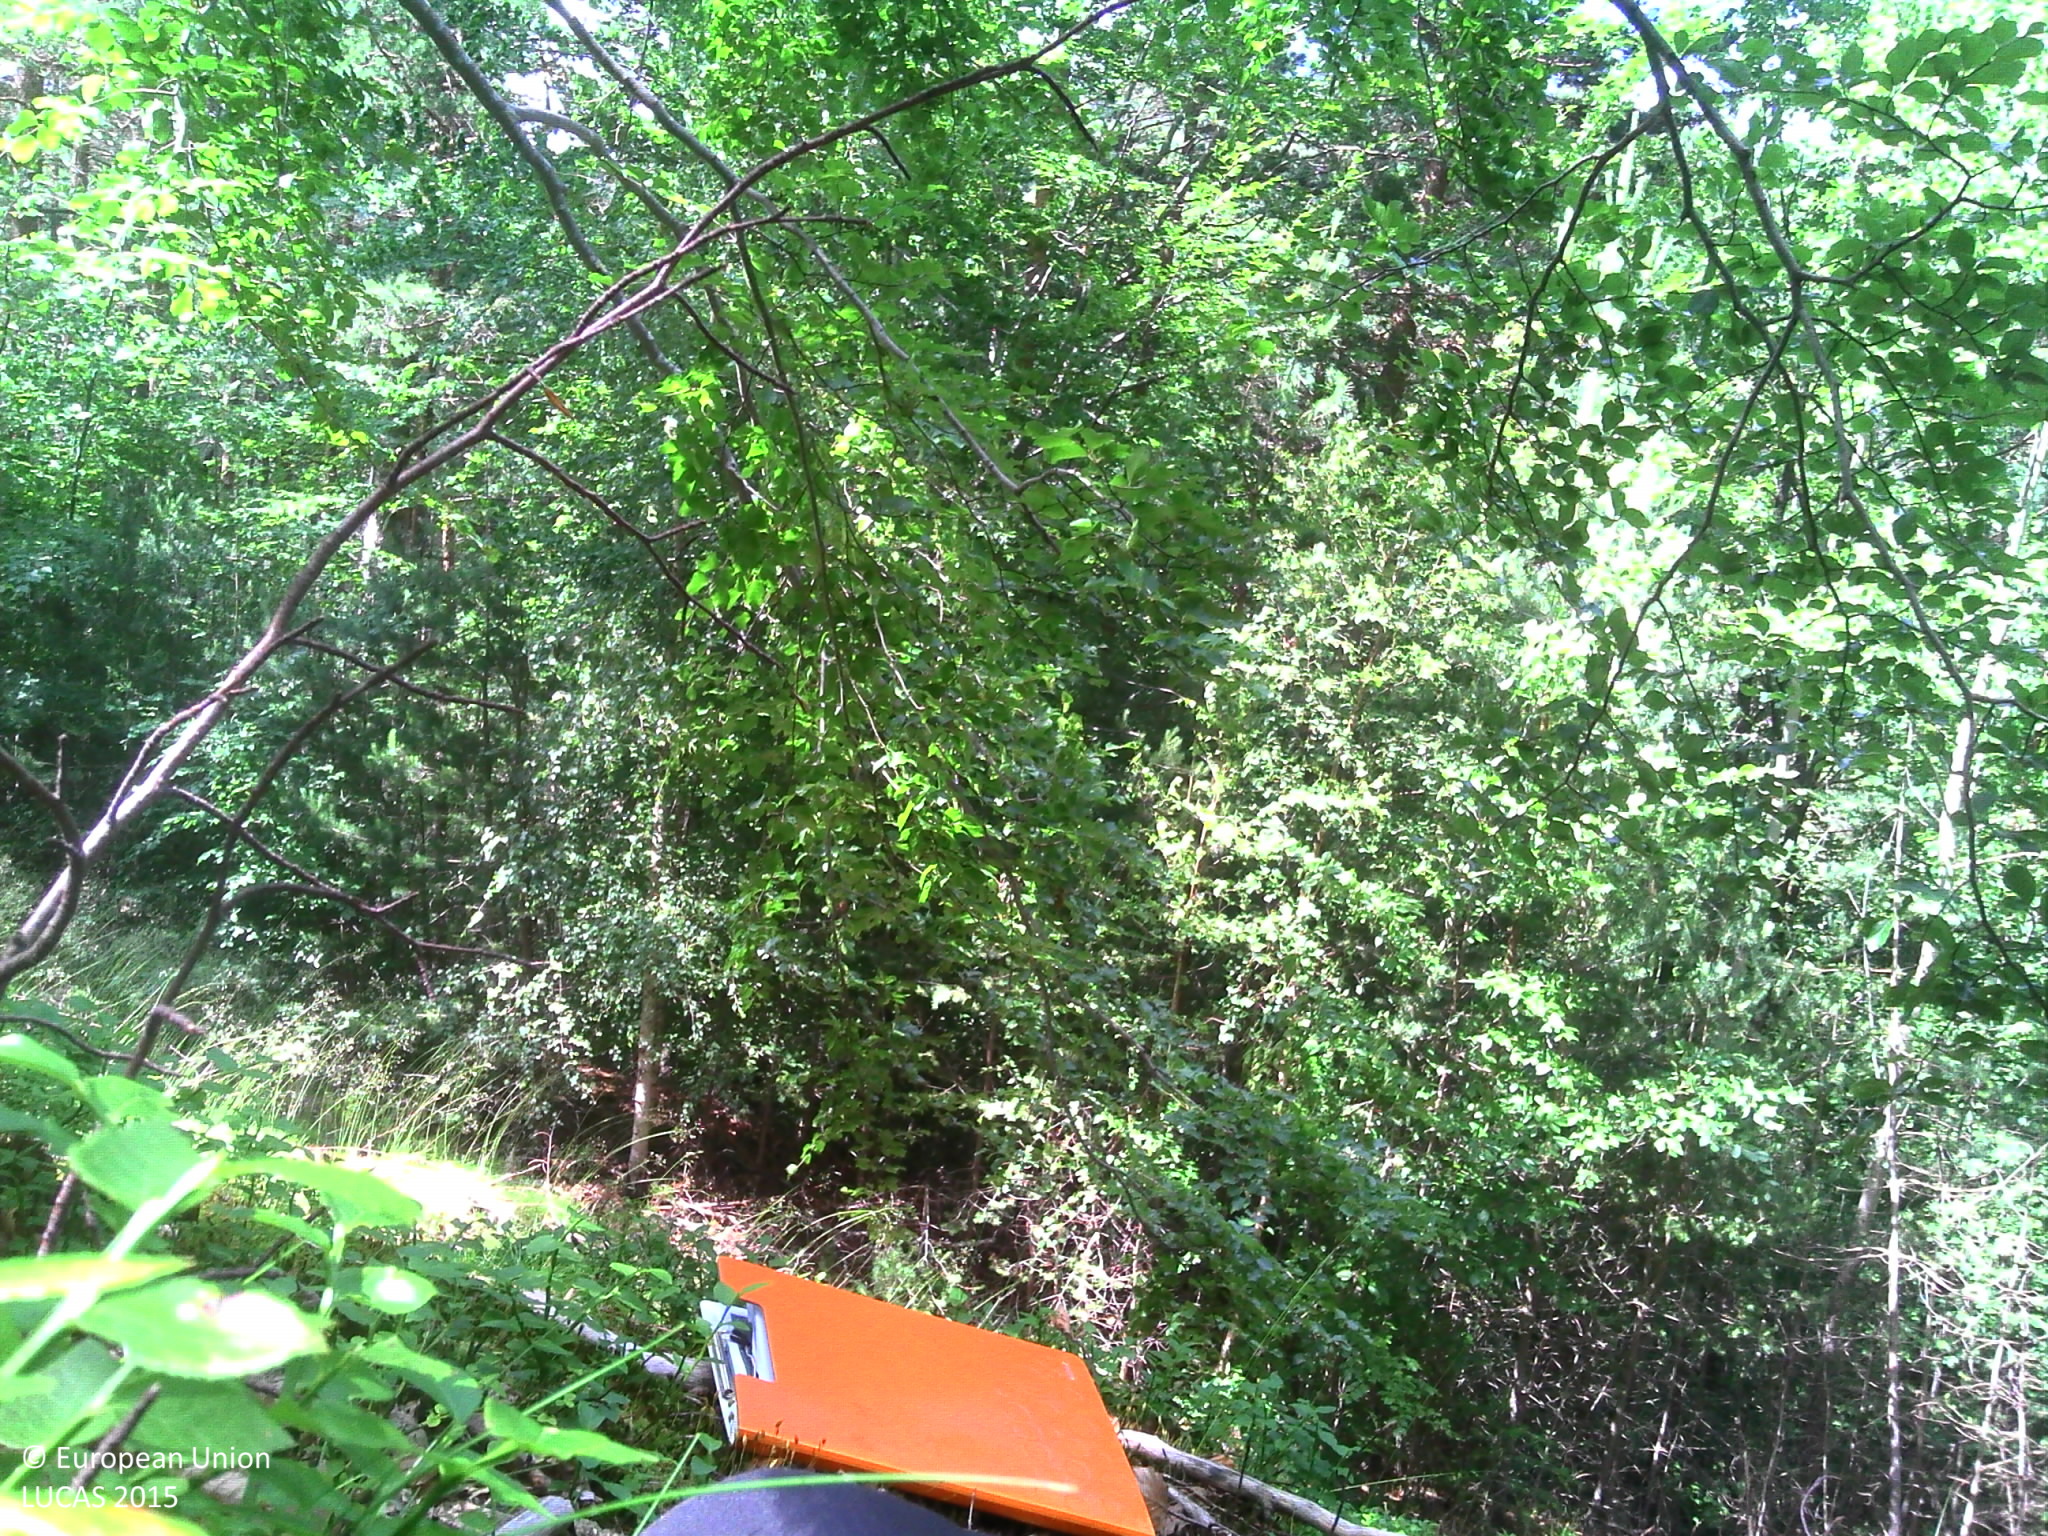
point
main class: Woodland
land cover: Other mixed woodland
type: mountainous beech forest
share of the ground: > 75 %
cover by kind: broadleaved forest trees 65 %, coniferous forest trees 25 %, herbaceous plants 10 %
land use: Forestry
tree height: > 5 m
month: June
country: FR
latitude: 44.5703
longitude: 3.9238
